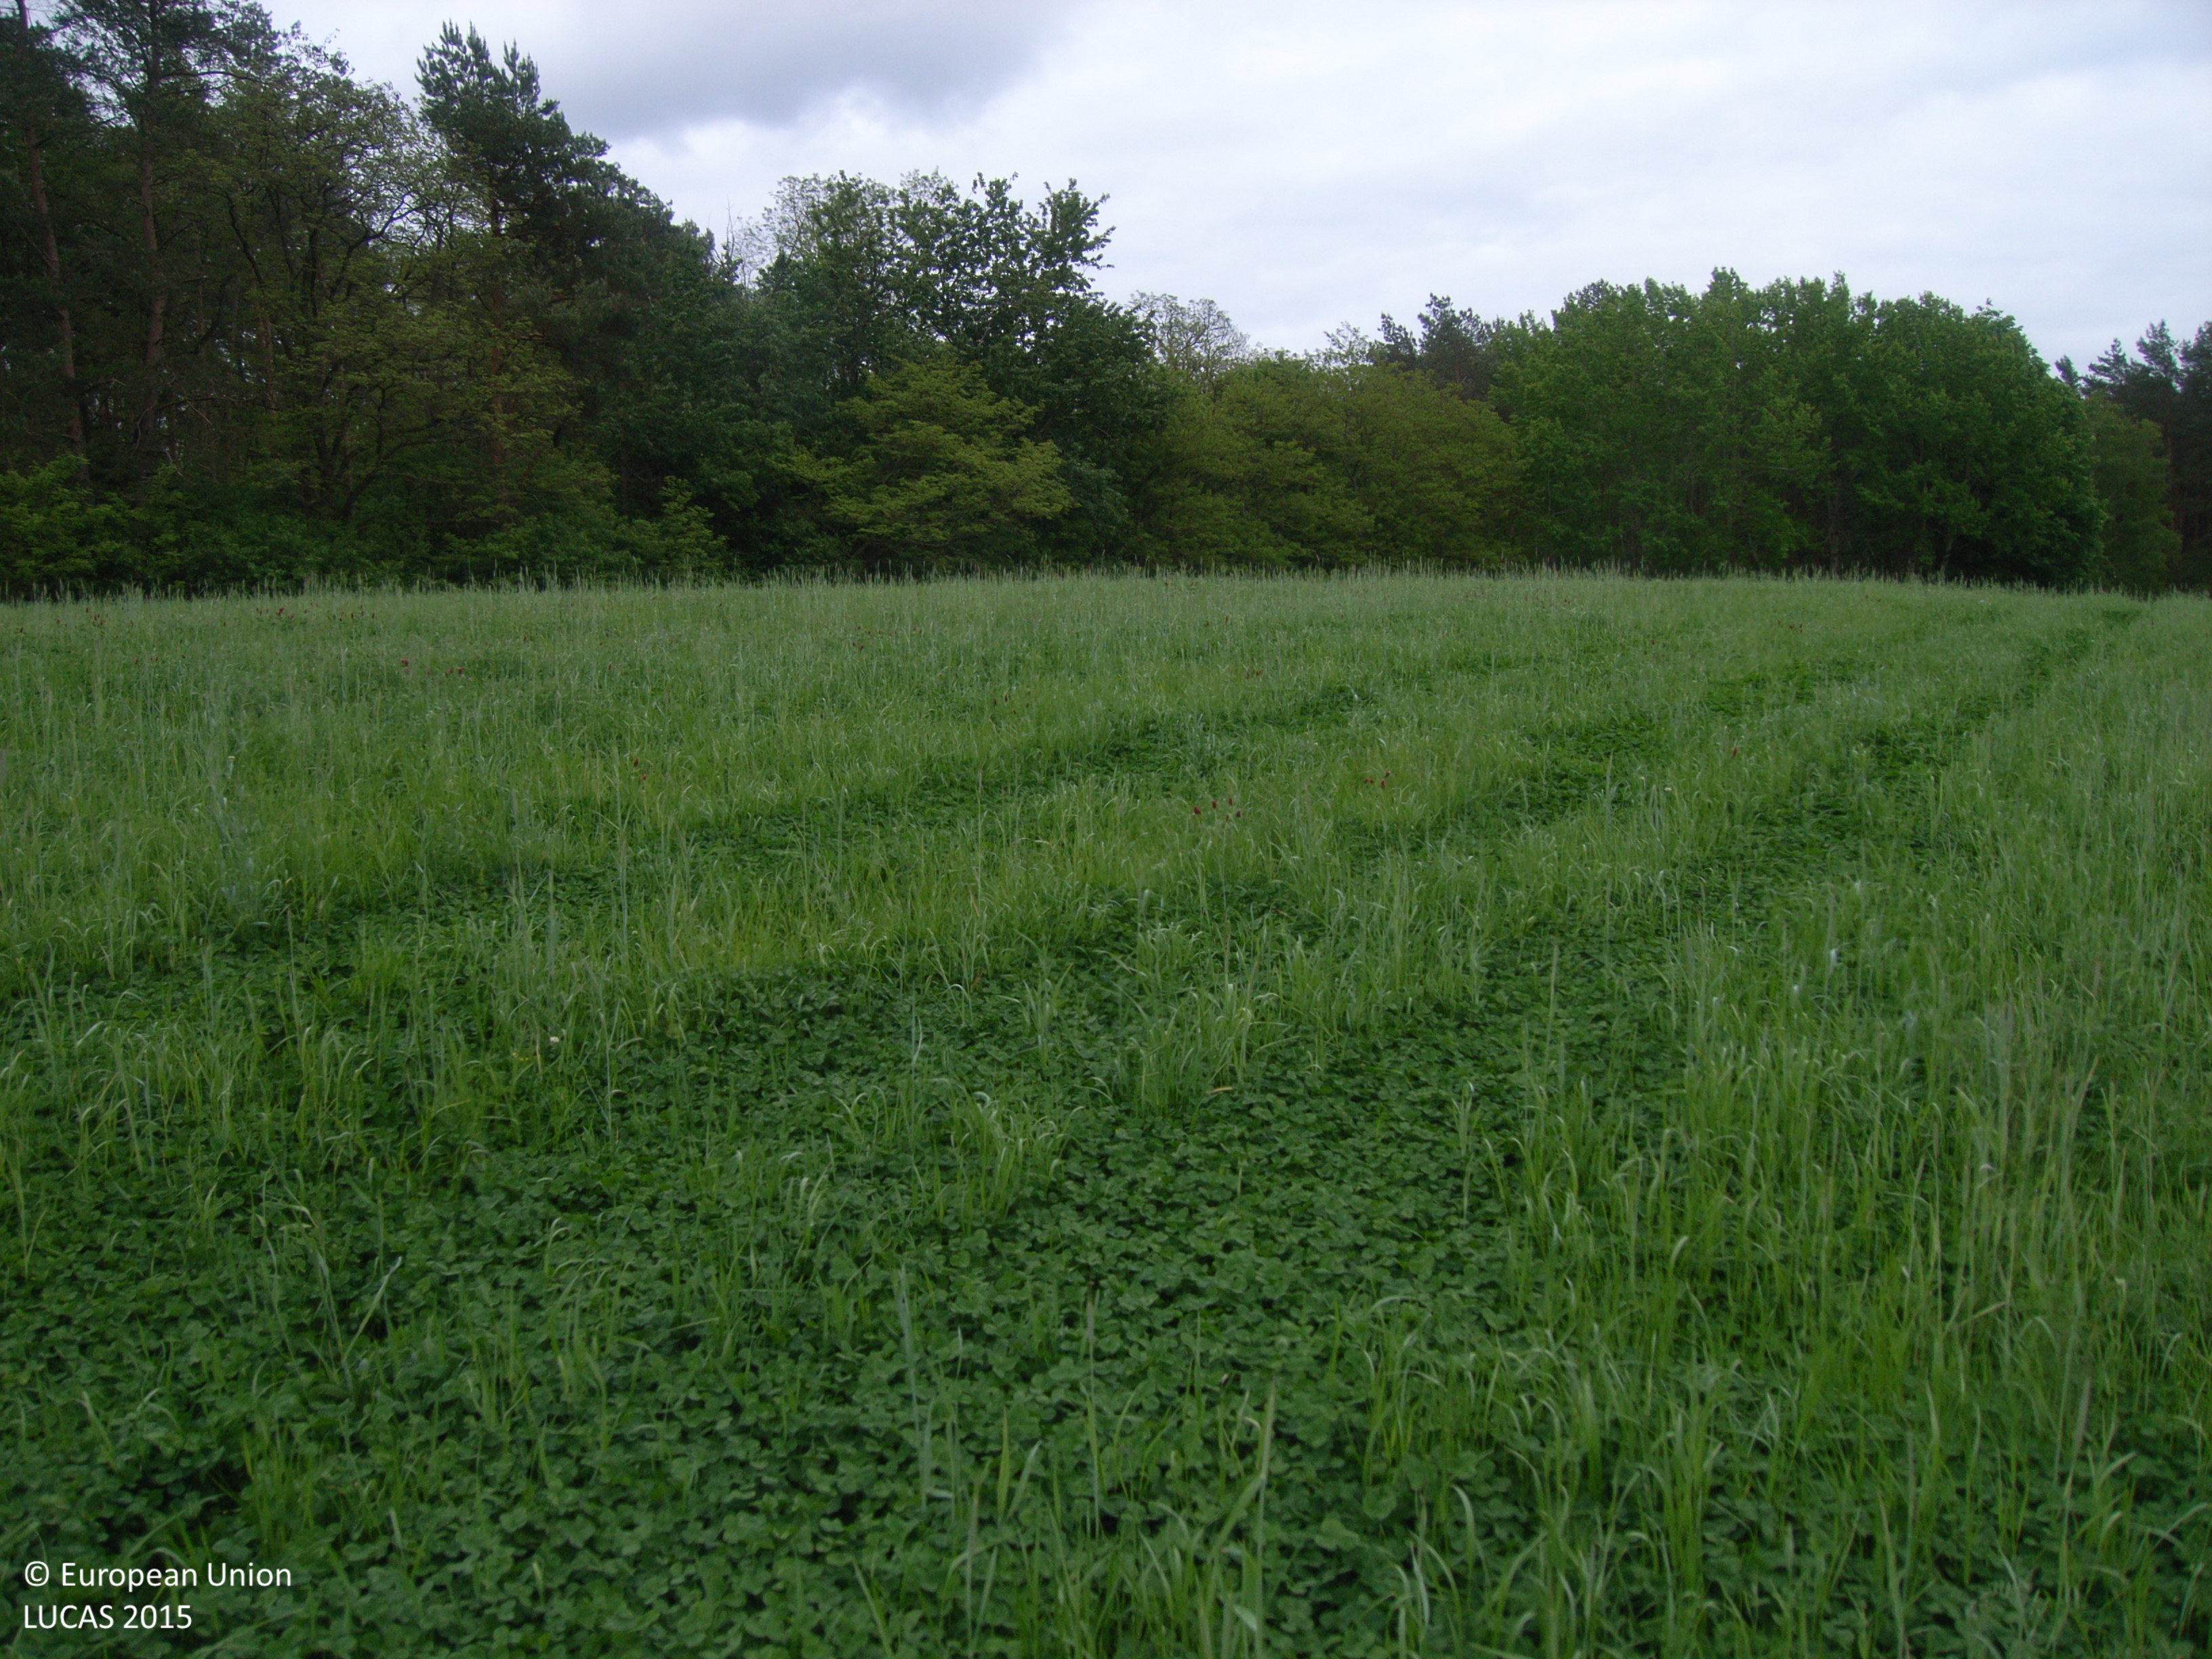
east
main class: Cropland
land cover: Other leguminous and mixtures for fodder
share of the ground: > 75 %
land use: Agriculture (excluding fallow land and kitchen gardens)
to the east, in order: Other leguminous and mixtures for fodder; Pine dominated mixed woodland; Tracks; Pine dominated mixed woodland; Other leguminous and mixtures for fodder
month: May
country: DE
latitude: 52.1436
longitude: 13.5805
